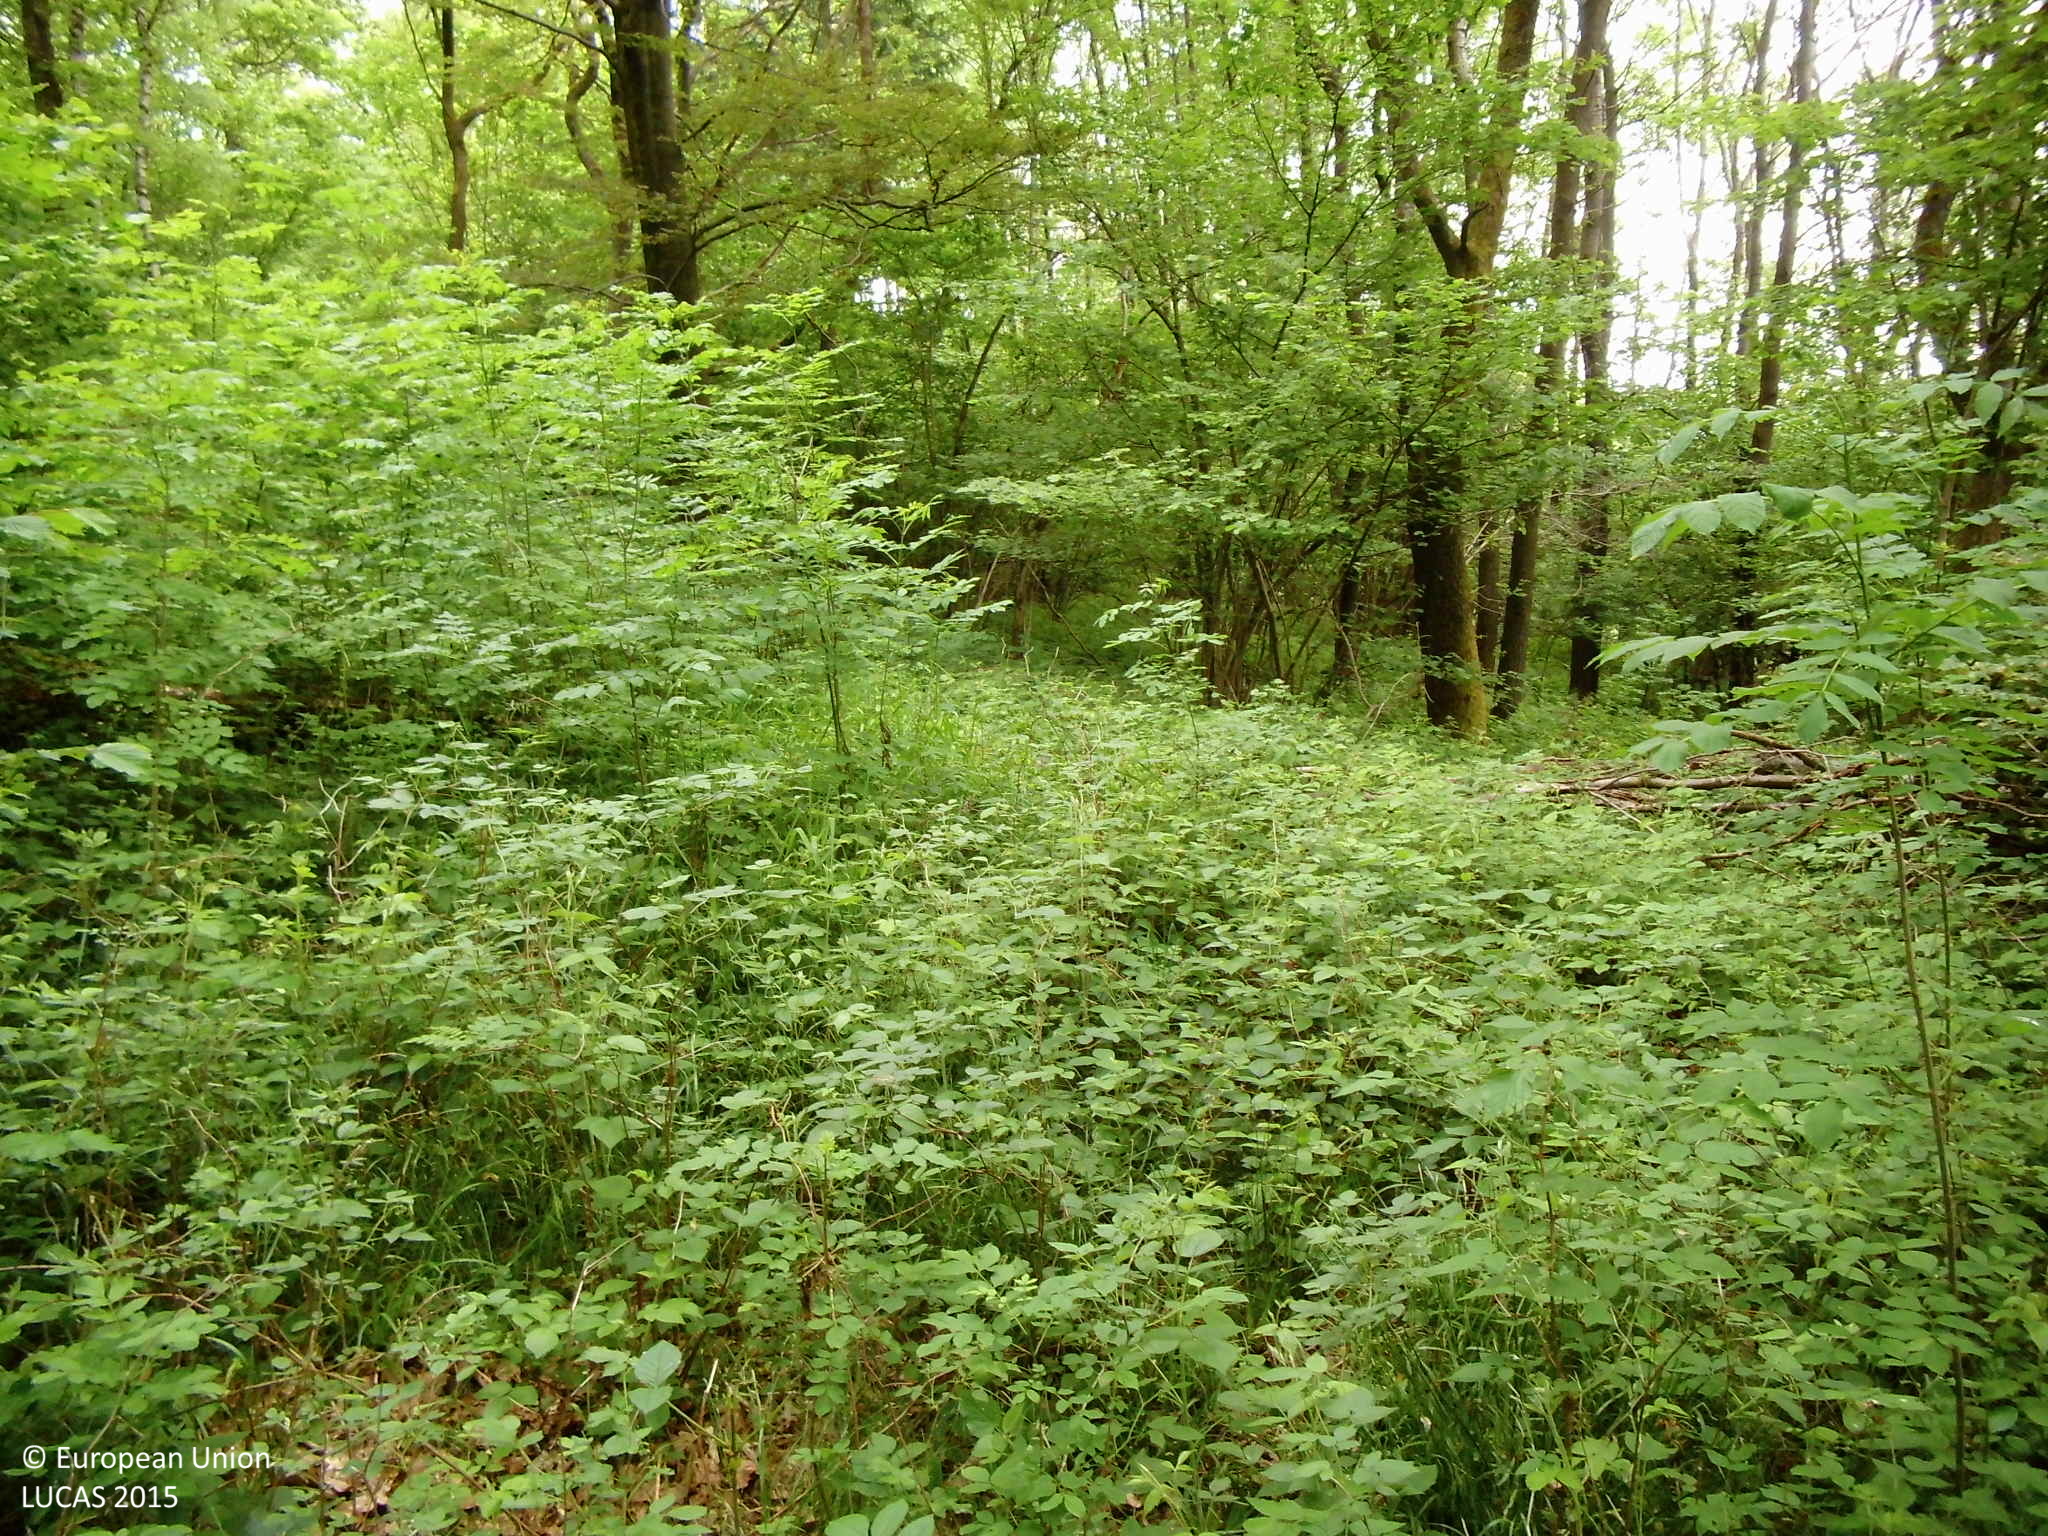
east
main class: Woodland
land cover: Broadleaved woodland
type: mesophytic deciduous forest
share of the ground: > 75 %
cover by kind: broadleaved forest trees 85 %, shrubs 10 %, herbaceous plants 5 %
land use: Forestry
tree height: > 5 m
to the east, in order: Broadleaved woodland; Spruce dominated mixed woodland; Tracks; Spontaneously vegetated surfaces; Spruce dominated coniferous woodland; Fences; Other bare soil; Grassland without tree/shrub cover
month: June
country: DE
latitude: 51.0663
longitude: 8.0168
